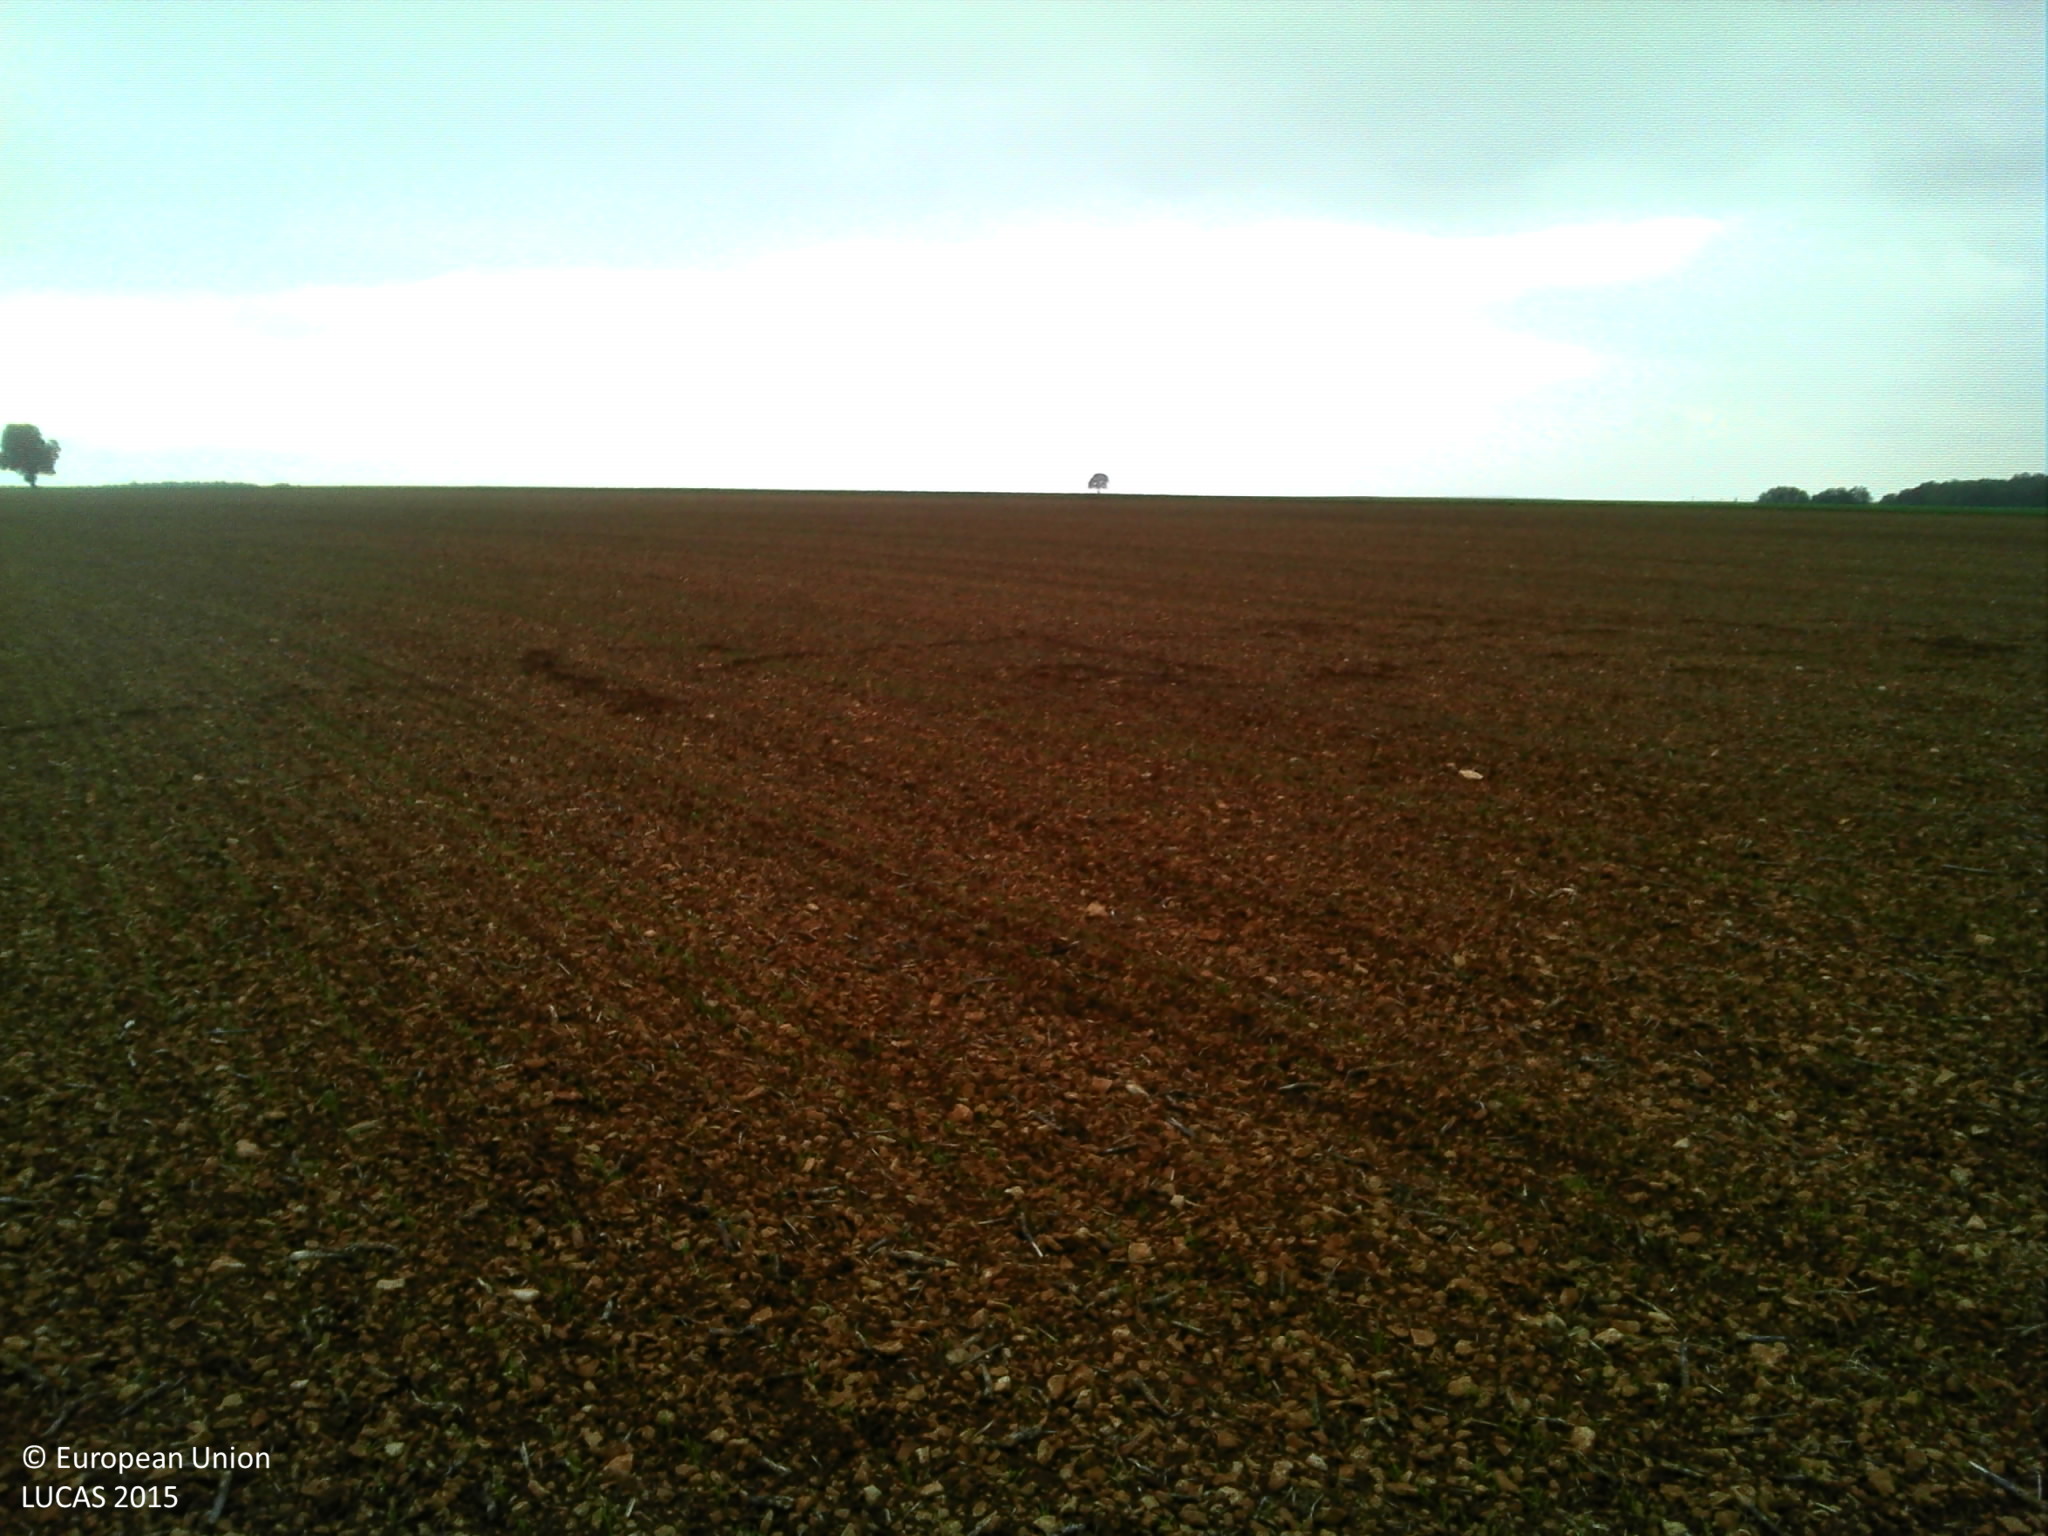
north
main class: Cropland
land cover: Common wheat
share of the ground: < 10 %
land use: Agriculture (excluding fallow land and kitchen gardens)
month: October
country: FR
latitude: 47.5879
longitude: 5.0134
